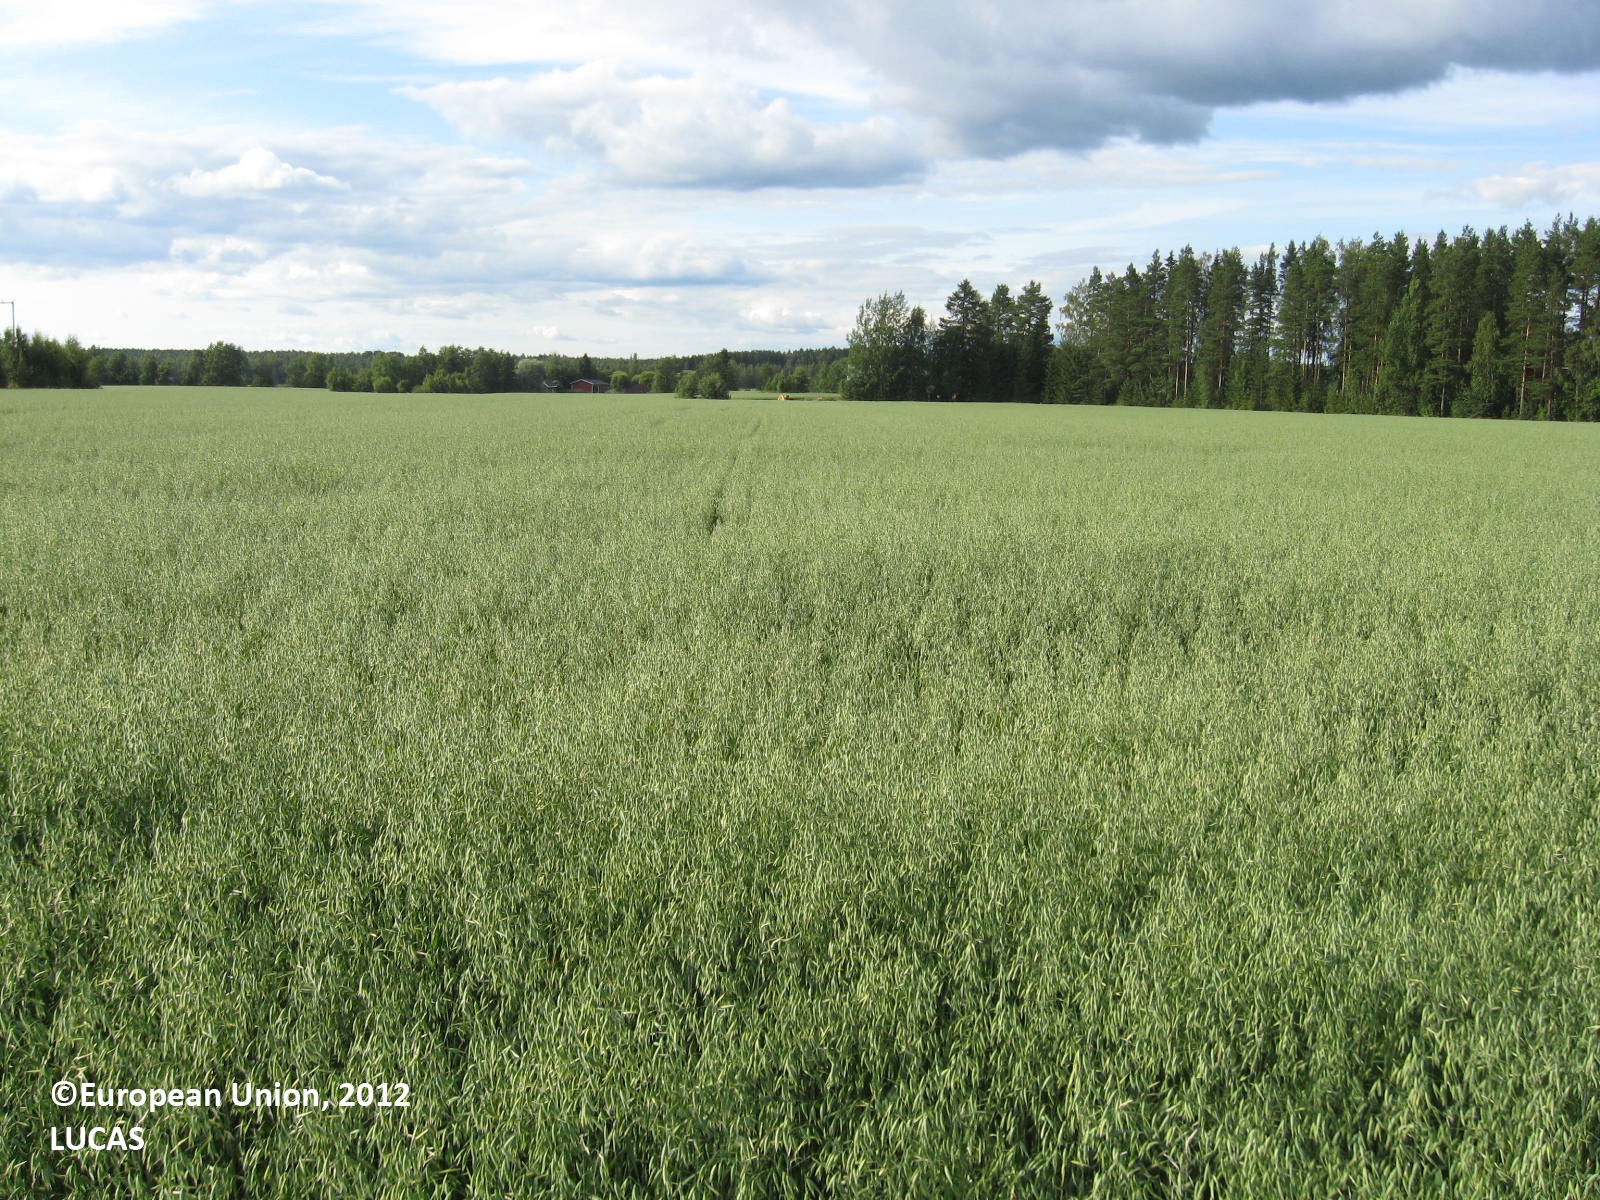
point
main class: Cropland
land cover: Oats
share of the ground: > 75 %
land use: Agriculture (excluding fallow land and kitchen gardens)
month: July
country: FI
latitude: 61.9852
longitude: 22.2127
